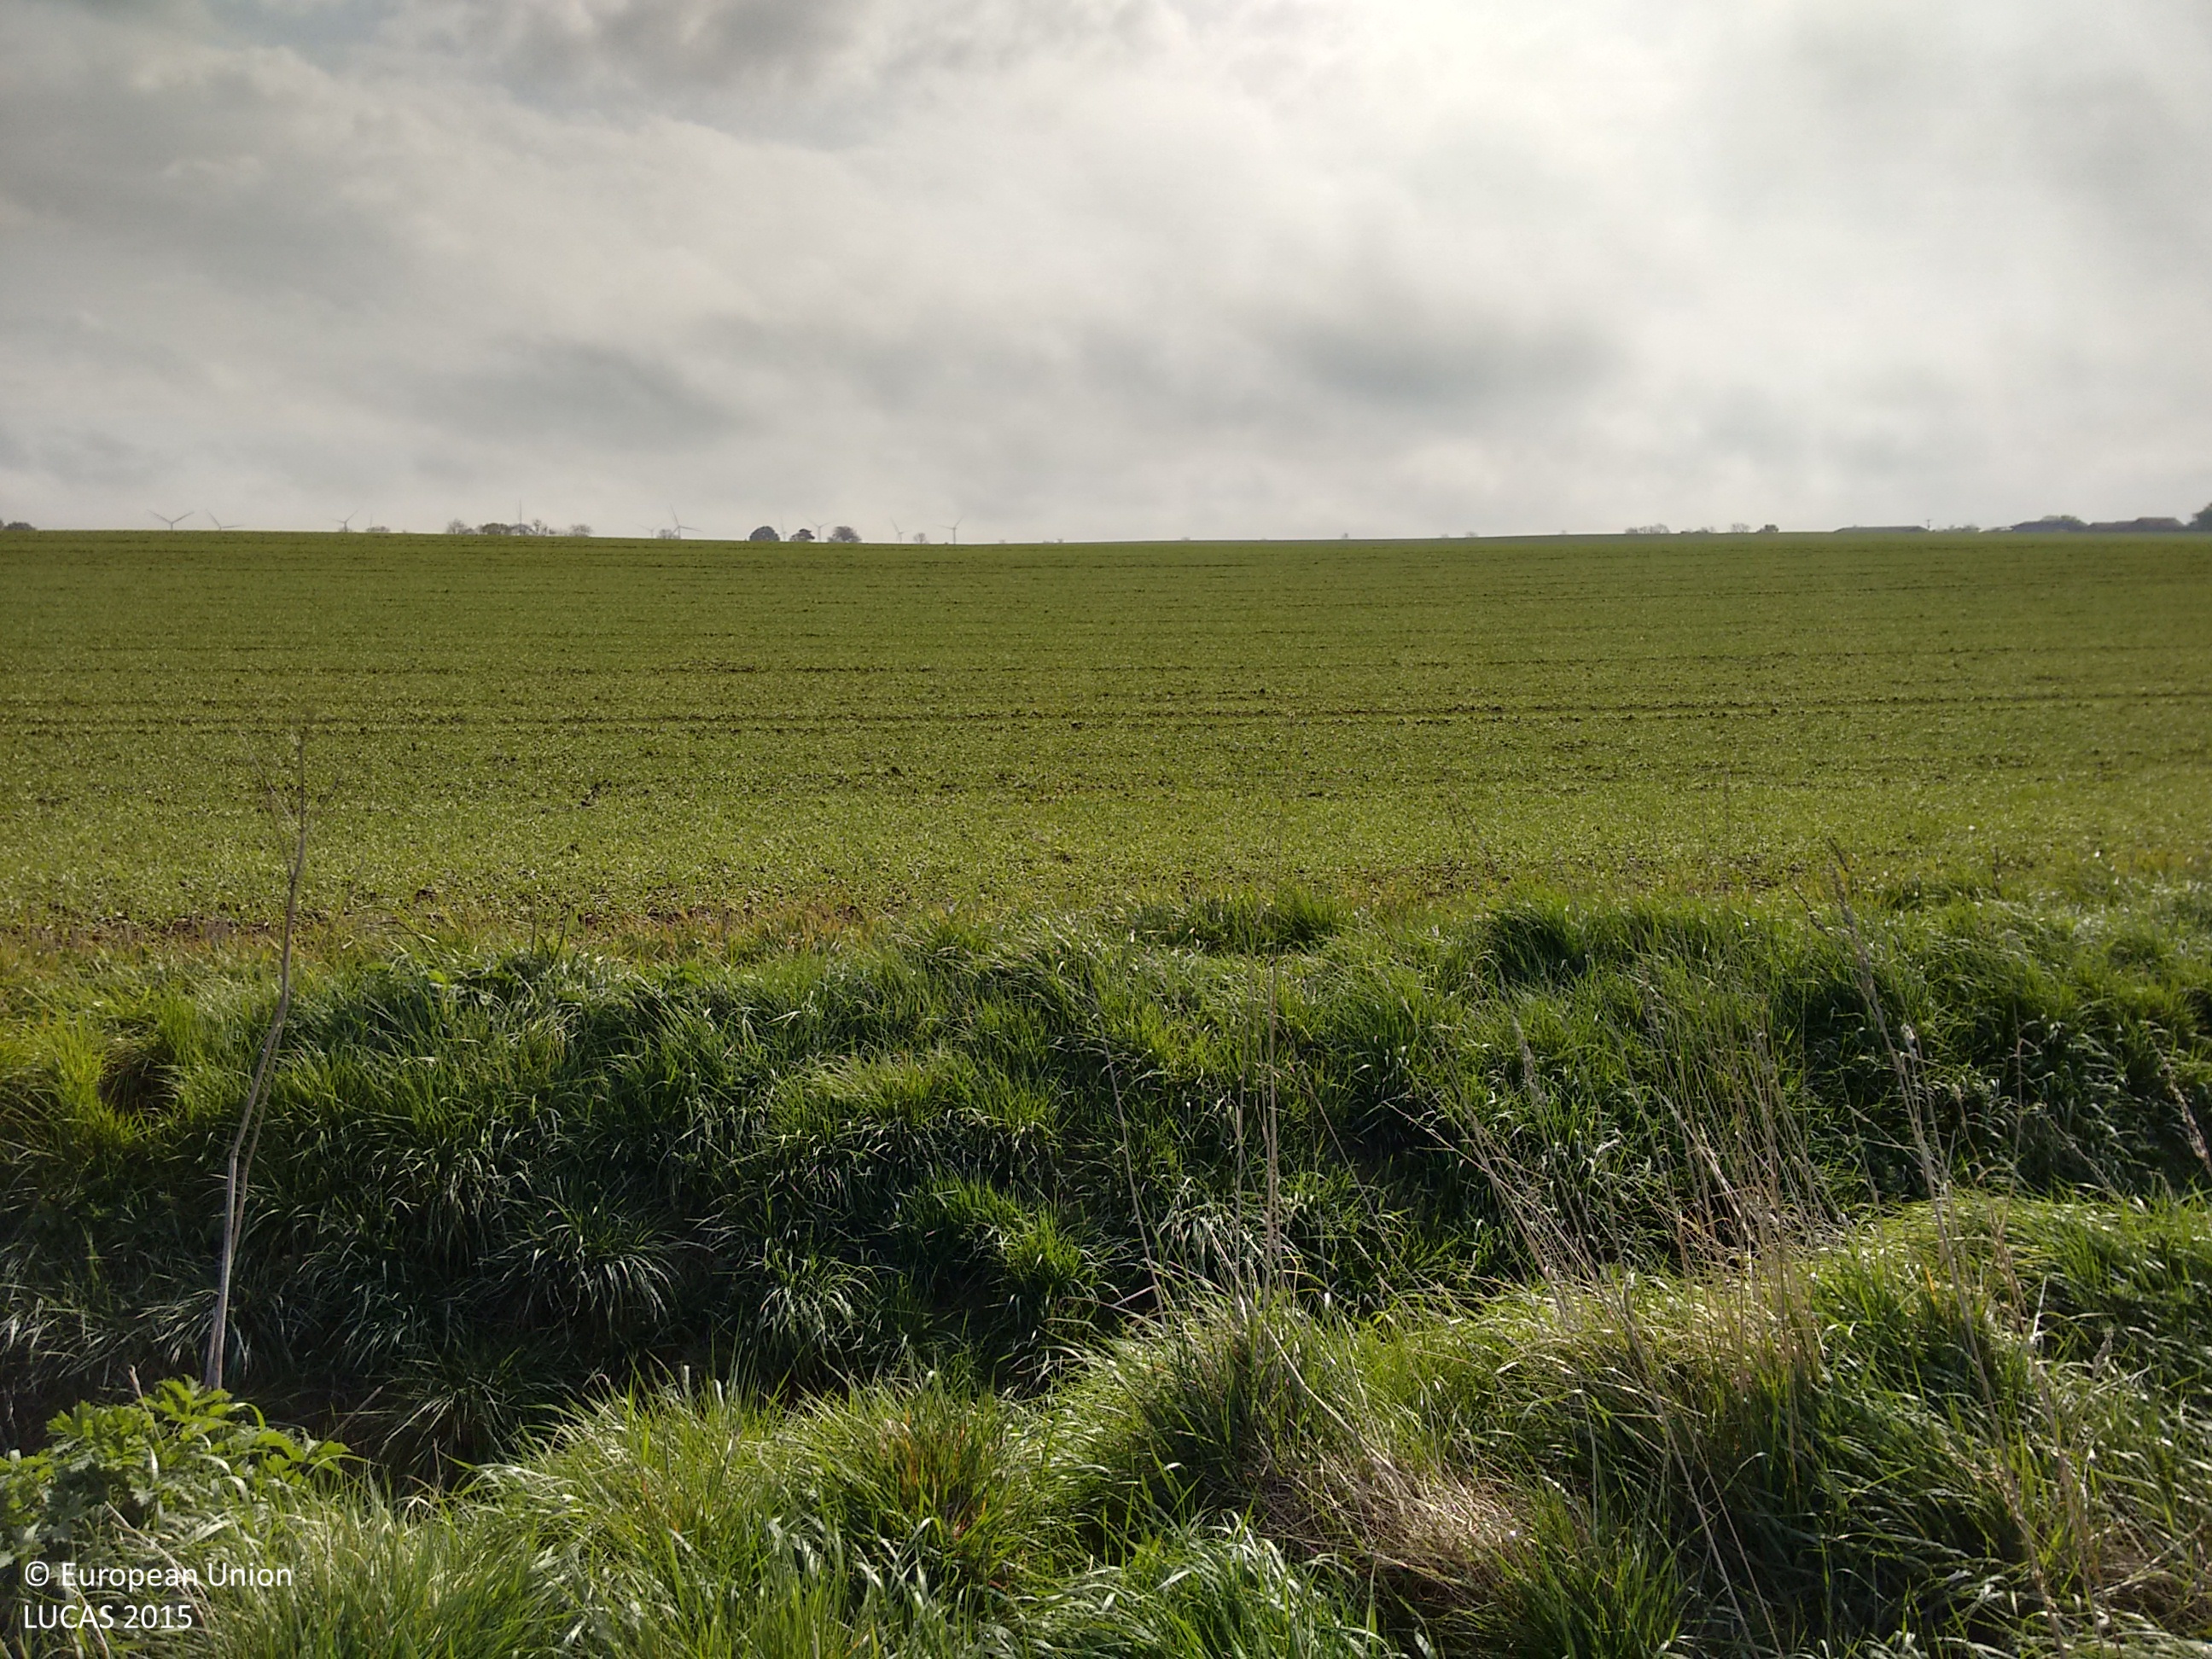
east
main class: Grassland
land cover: Grassland without tree/shrub cover
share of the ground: > 75 %
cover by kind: herbaceous plants 100 %
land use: Agriculture (excluding fallow land and kitchen gardens)
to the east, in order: Grassland without tree/shrub cover; Ditches and canals; Grass margins; Barley
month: May
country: GB
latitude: 53.9924
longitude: -0.3303
